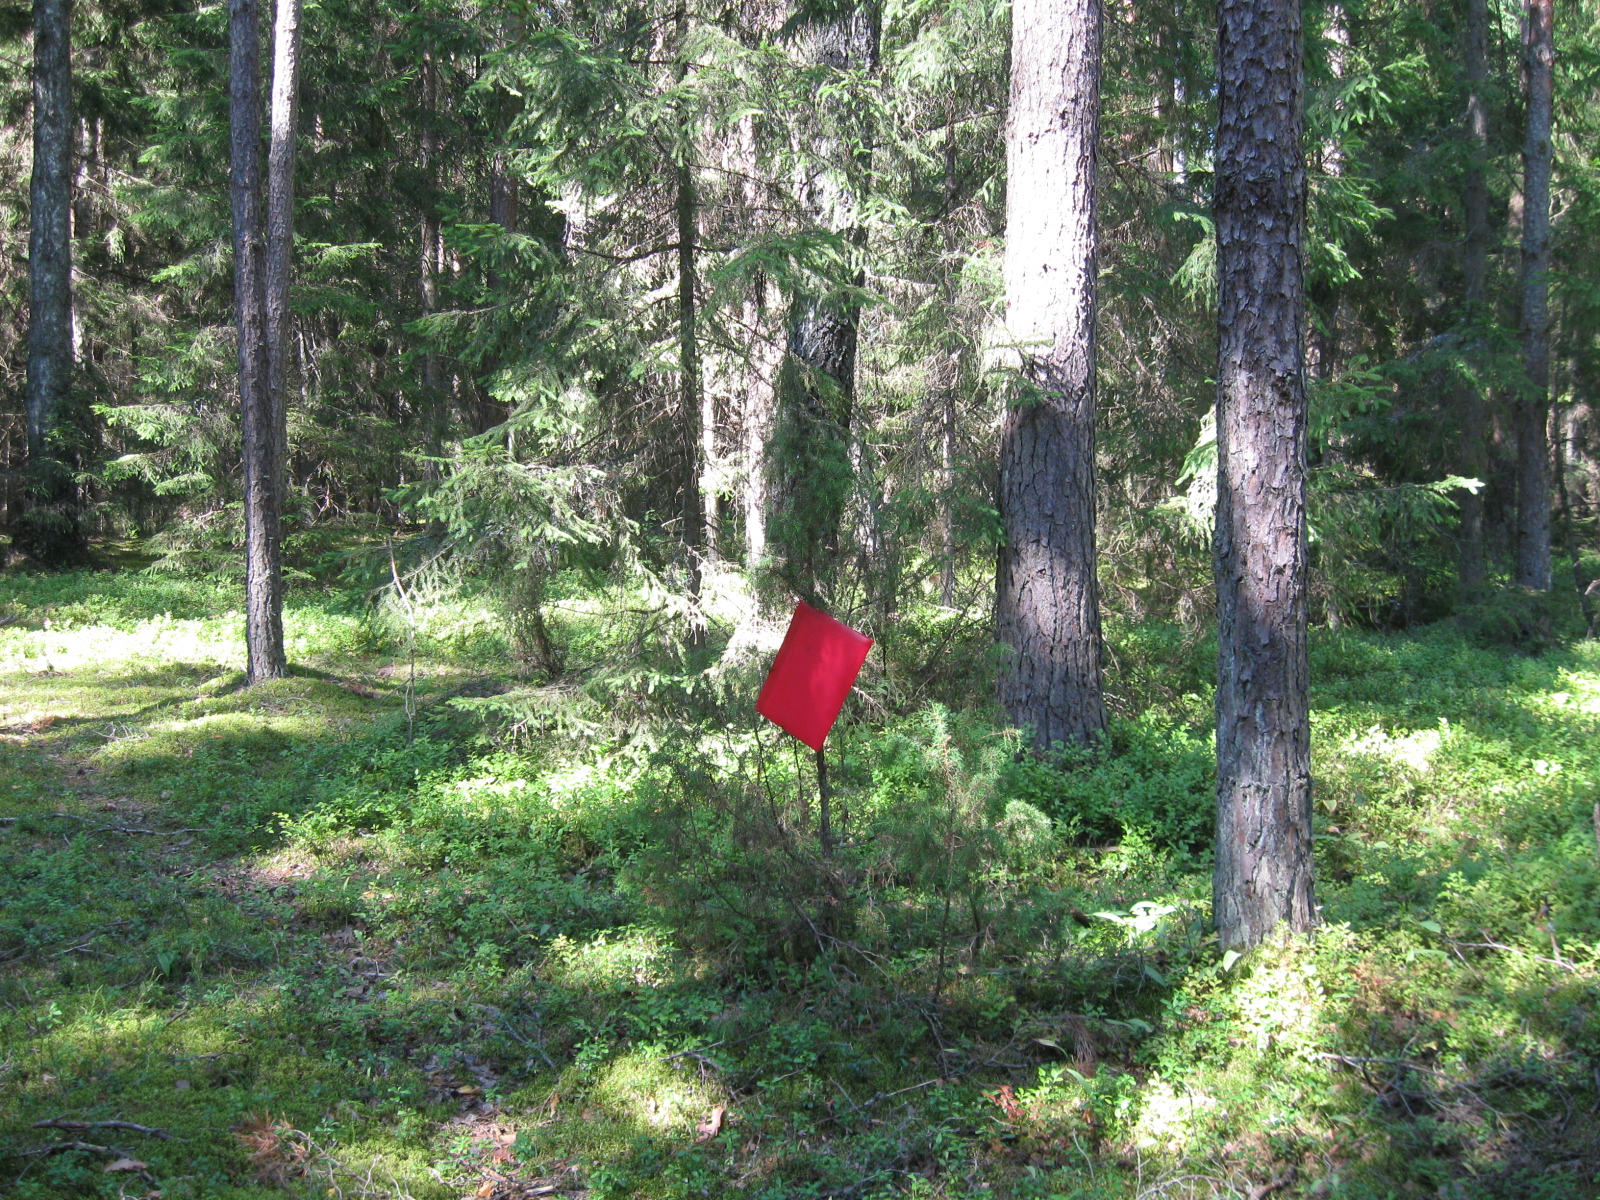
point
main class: Woodland
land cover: Other coniferous woodland
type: hemiboreal forest and nemoral coniferous forest and mixed broadleaved-coniferous forest
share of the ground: > 75 %
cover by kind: coniferous forest trees 85 %, lichens and mosses 10 %, shrubs 5 %
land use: Forestry
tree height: > 5 m
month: August
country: LT
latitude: 54.9416
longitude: 23.4898
